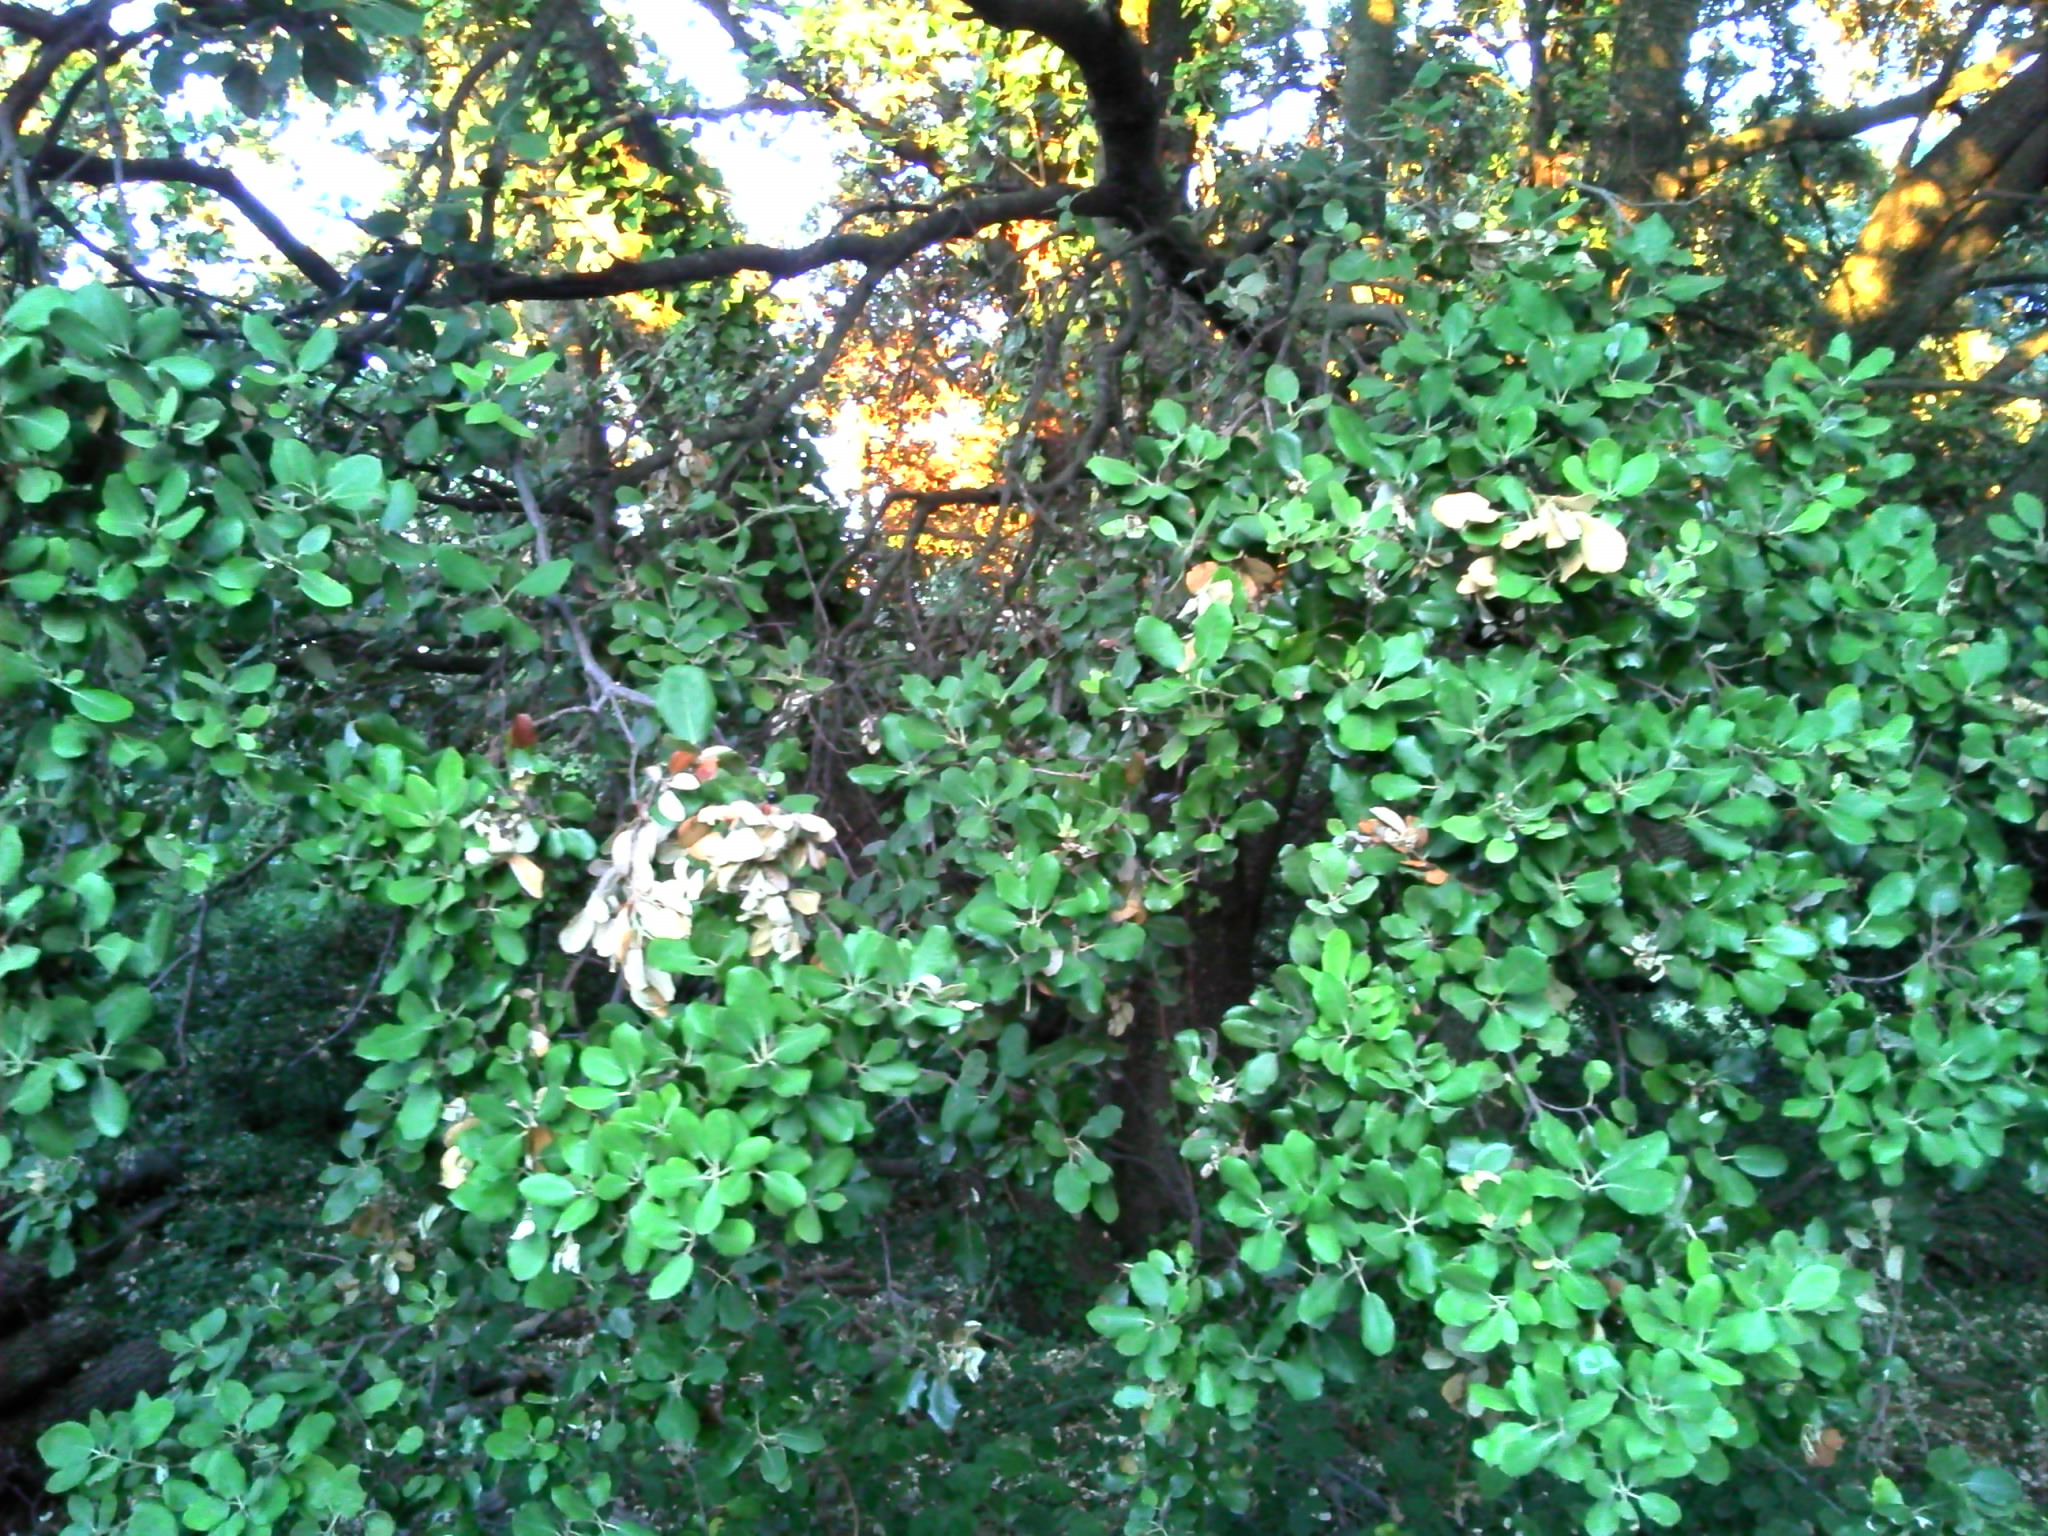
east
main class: Woodland
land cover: Broadleaved woodland
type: broadleaved evergreen forest
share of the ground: > 75 %
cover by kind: broadleaved forest trees 70 %, herbaceous plants 15 %, consolidated bare surface 15 %
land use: Forestry
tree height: > 5 m
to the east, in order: Broadleaved woodland; Shrubland without tree cover; Broadleaved woodland; Tracks; Shrubland without tree cover; Electric lines; Shrubland with sparse tree cover; Tracks; Shrubland without tree cover; Other bare soil; Electric lines; Shrubland without tree cover; Broadleaved woodland; Ditches and canals; Grass margins; Vineyards
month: August
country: FR
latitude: 43.9601
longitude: 4.6621
